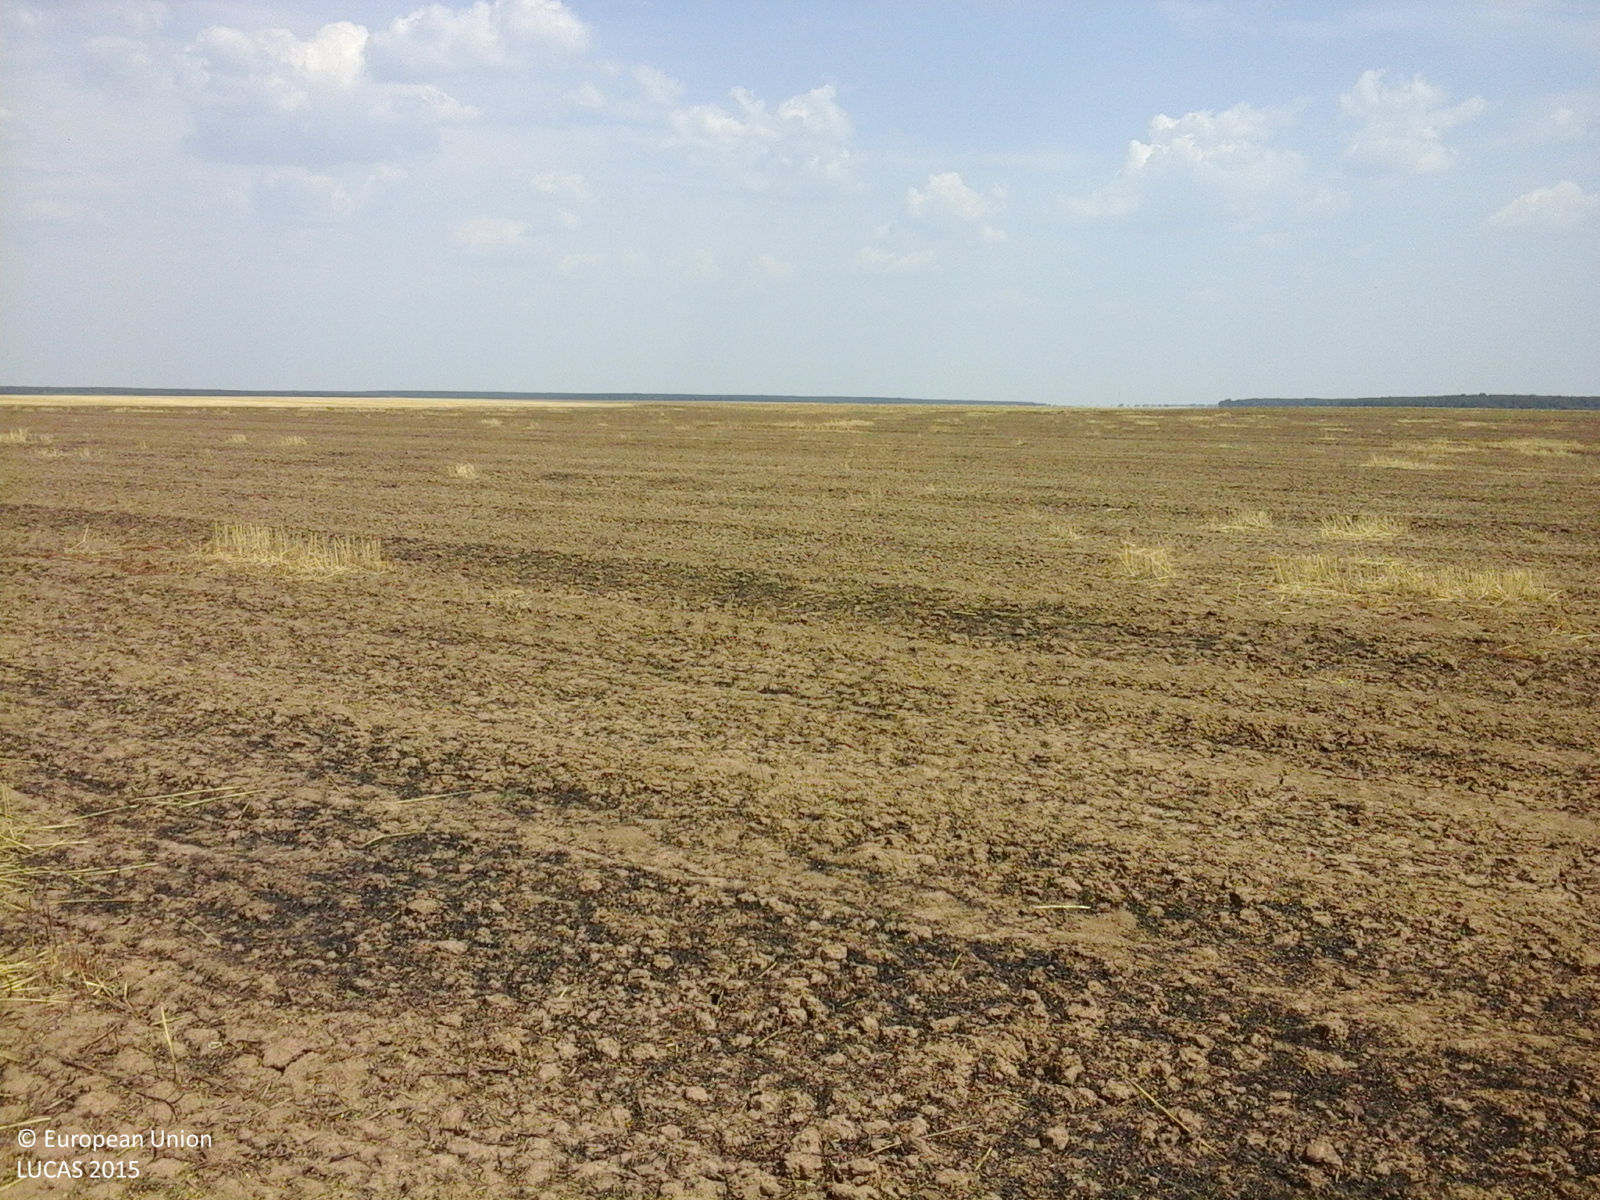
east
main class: Cropland
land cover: Common wheat
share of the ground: < 10 %
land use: Agriculture (excluding fallow land and kitchen gardens)
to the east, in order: Common wheat
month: August
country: RO
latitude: 44.2599
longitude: 23.1349
